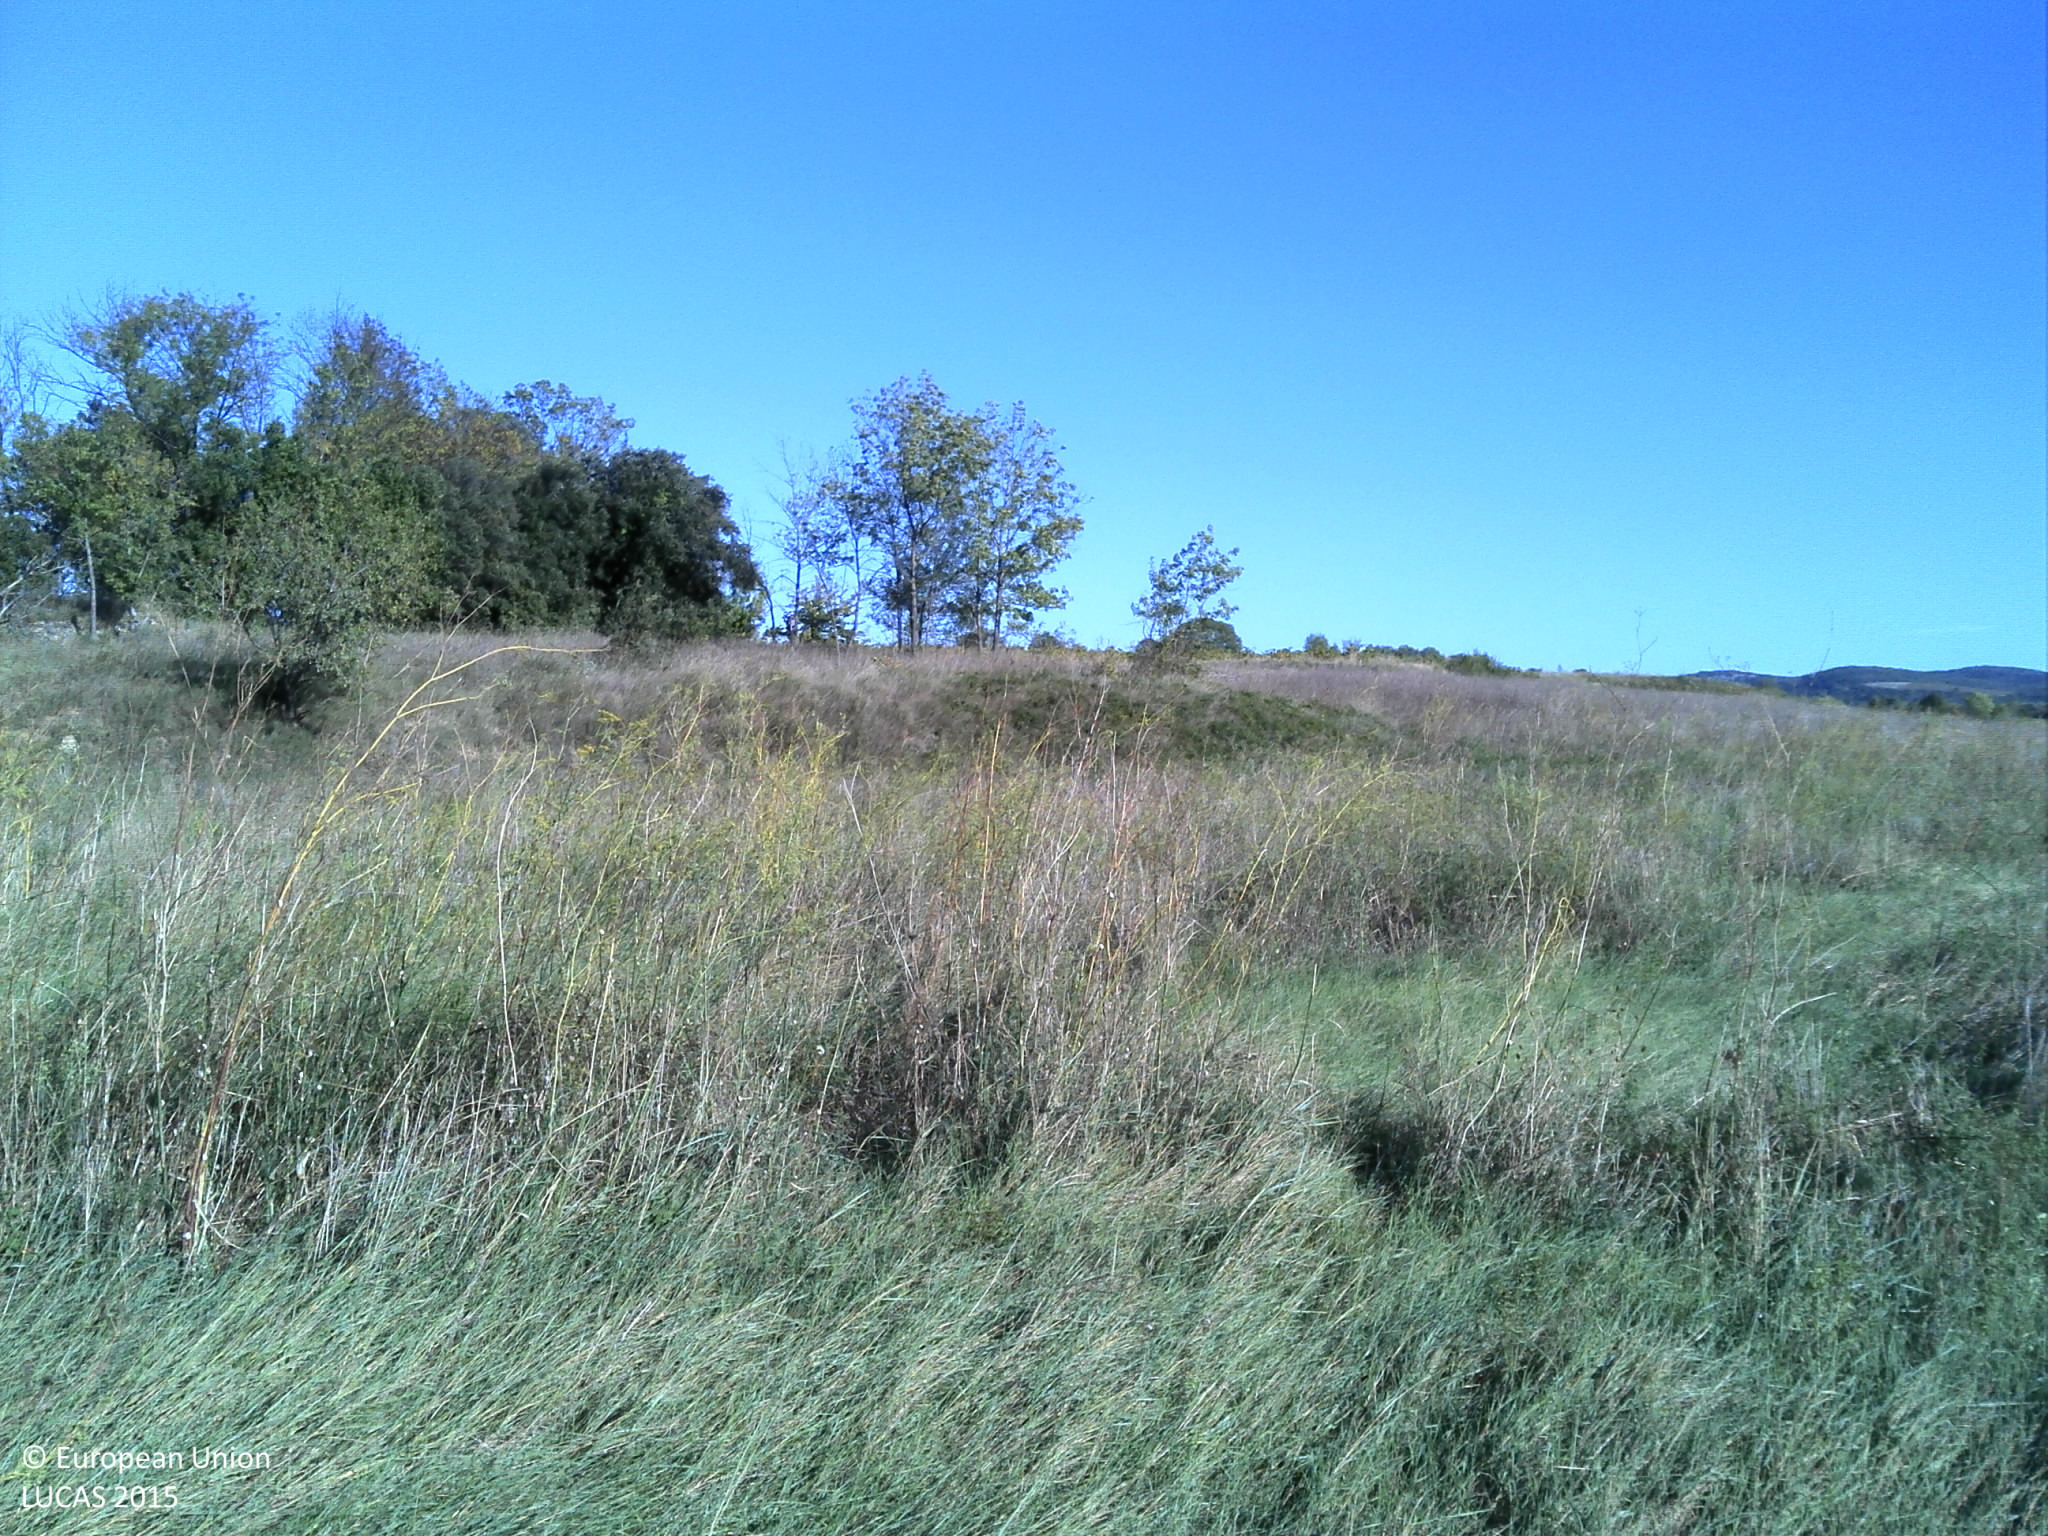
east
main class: Grassland
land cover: Grassland without tree/shrub cover
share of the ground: > 75 %
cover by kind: herbaceous plants 100 %
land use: Agriculture (excluding fallow land and kitchen gardens)
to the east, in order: Grassland without tree/shrub cover; Grassland with sparse tree/shrub cover; Broadleaved woodland; Ditches and canals; Grass margins; Vineyards; Grass margins; Tracks; Grass margins; Ditches and canals; Grassland without tree/shrub cover; Vineyards; Spruce dominated mixed woodland; Artificial constructions in urban areas
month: October
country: FR
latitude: 43.6432
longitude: 3.5499
